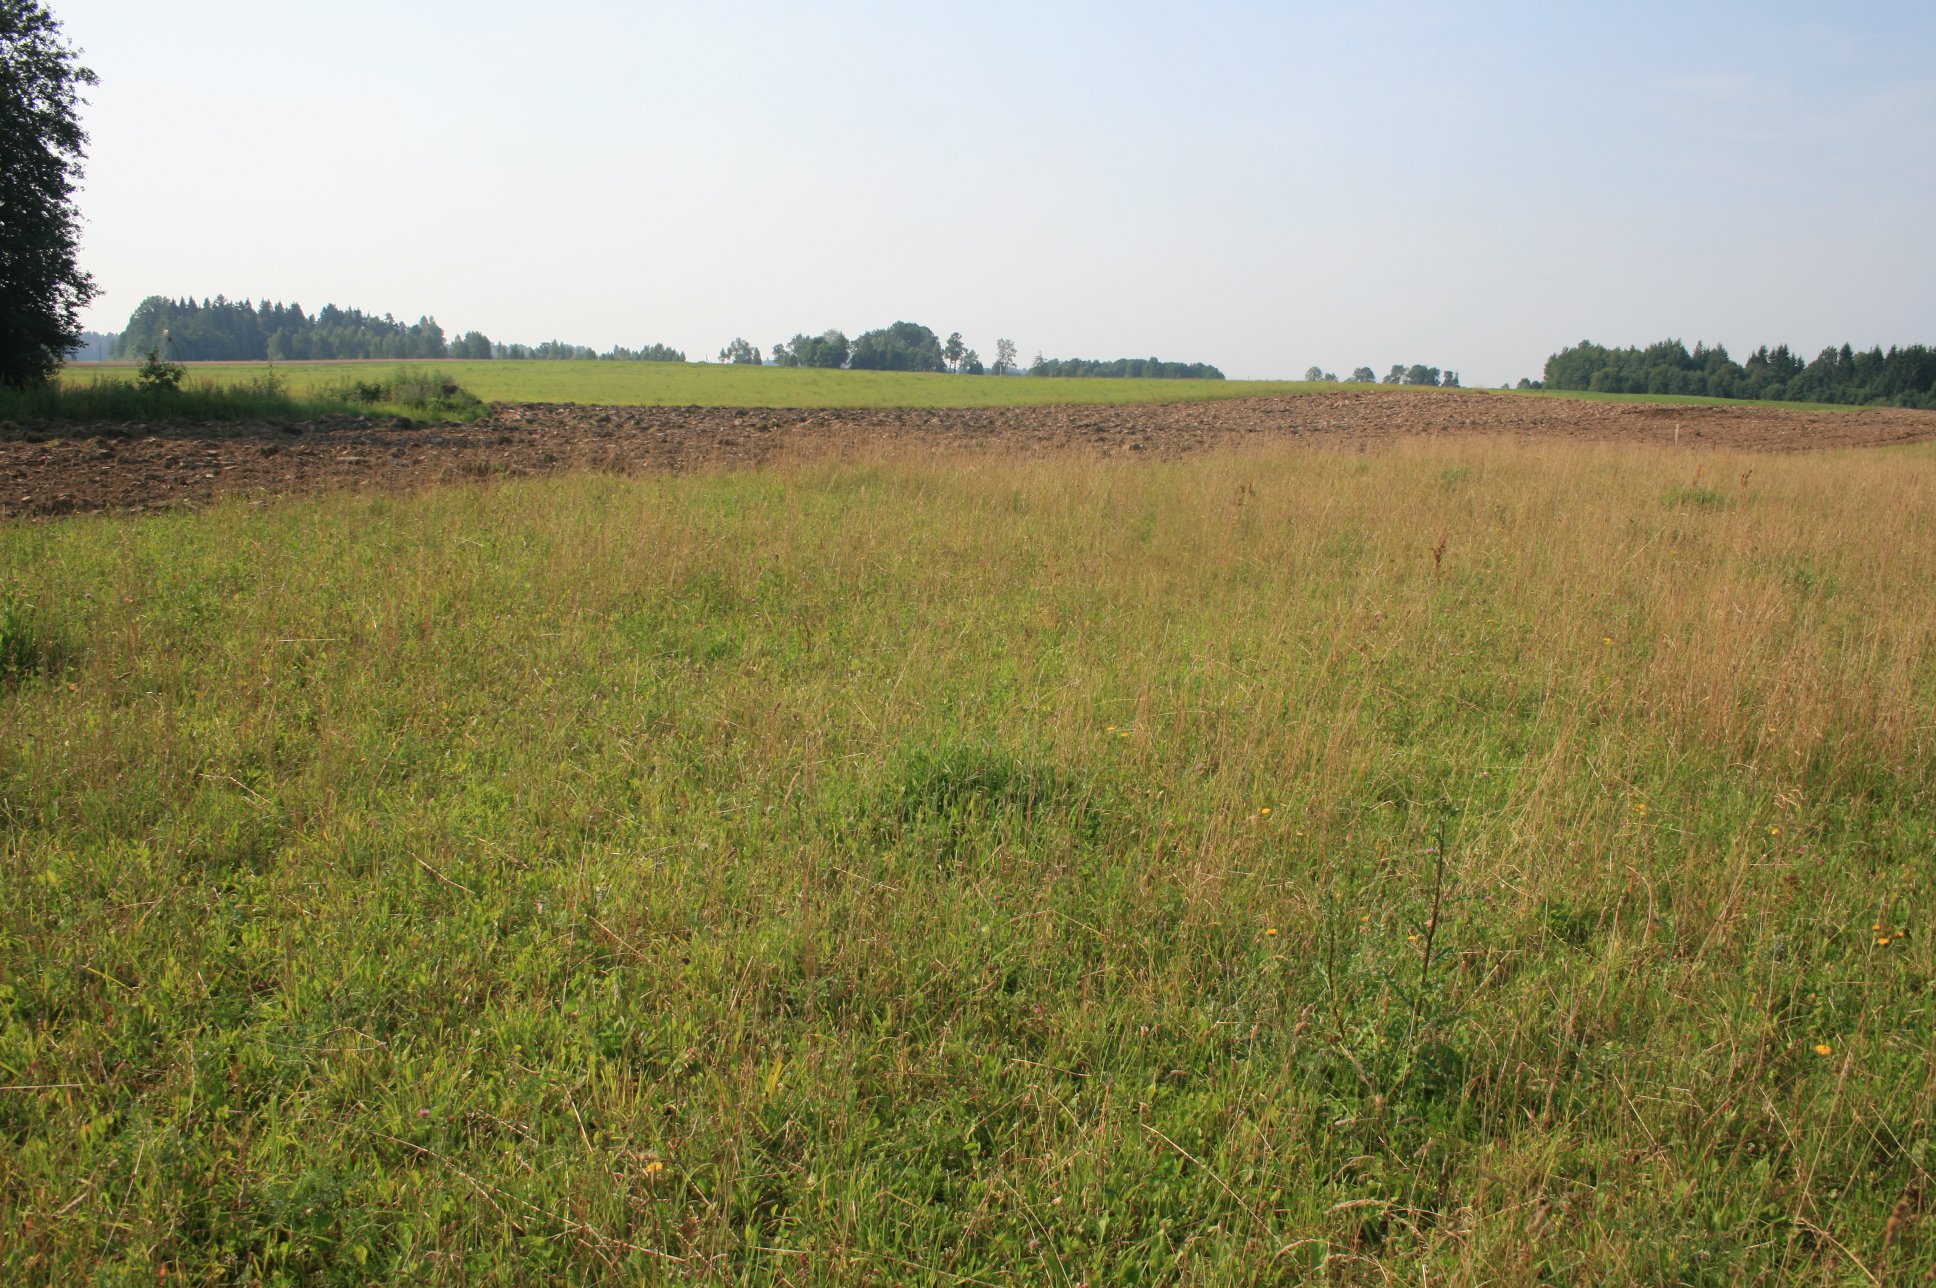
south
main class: Grassland
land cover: Grassland without tree/shrub cover
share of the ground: > 75 %
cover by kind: herbaceous plants 100 %
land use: Agriculture (excluding fallow land and kitchen gardens)
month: August
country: LT
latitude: 55.6036
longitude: 21.8114
